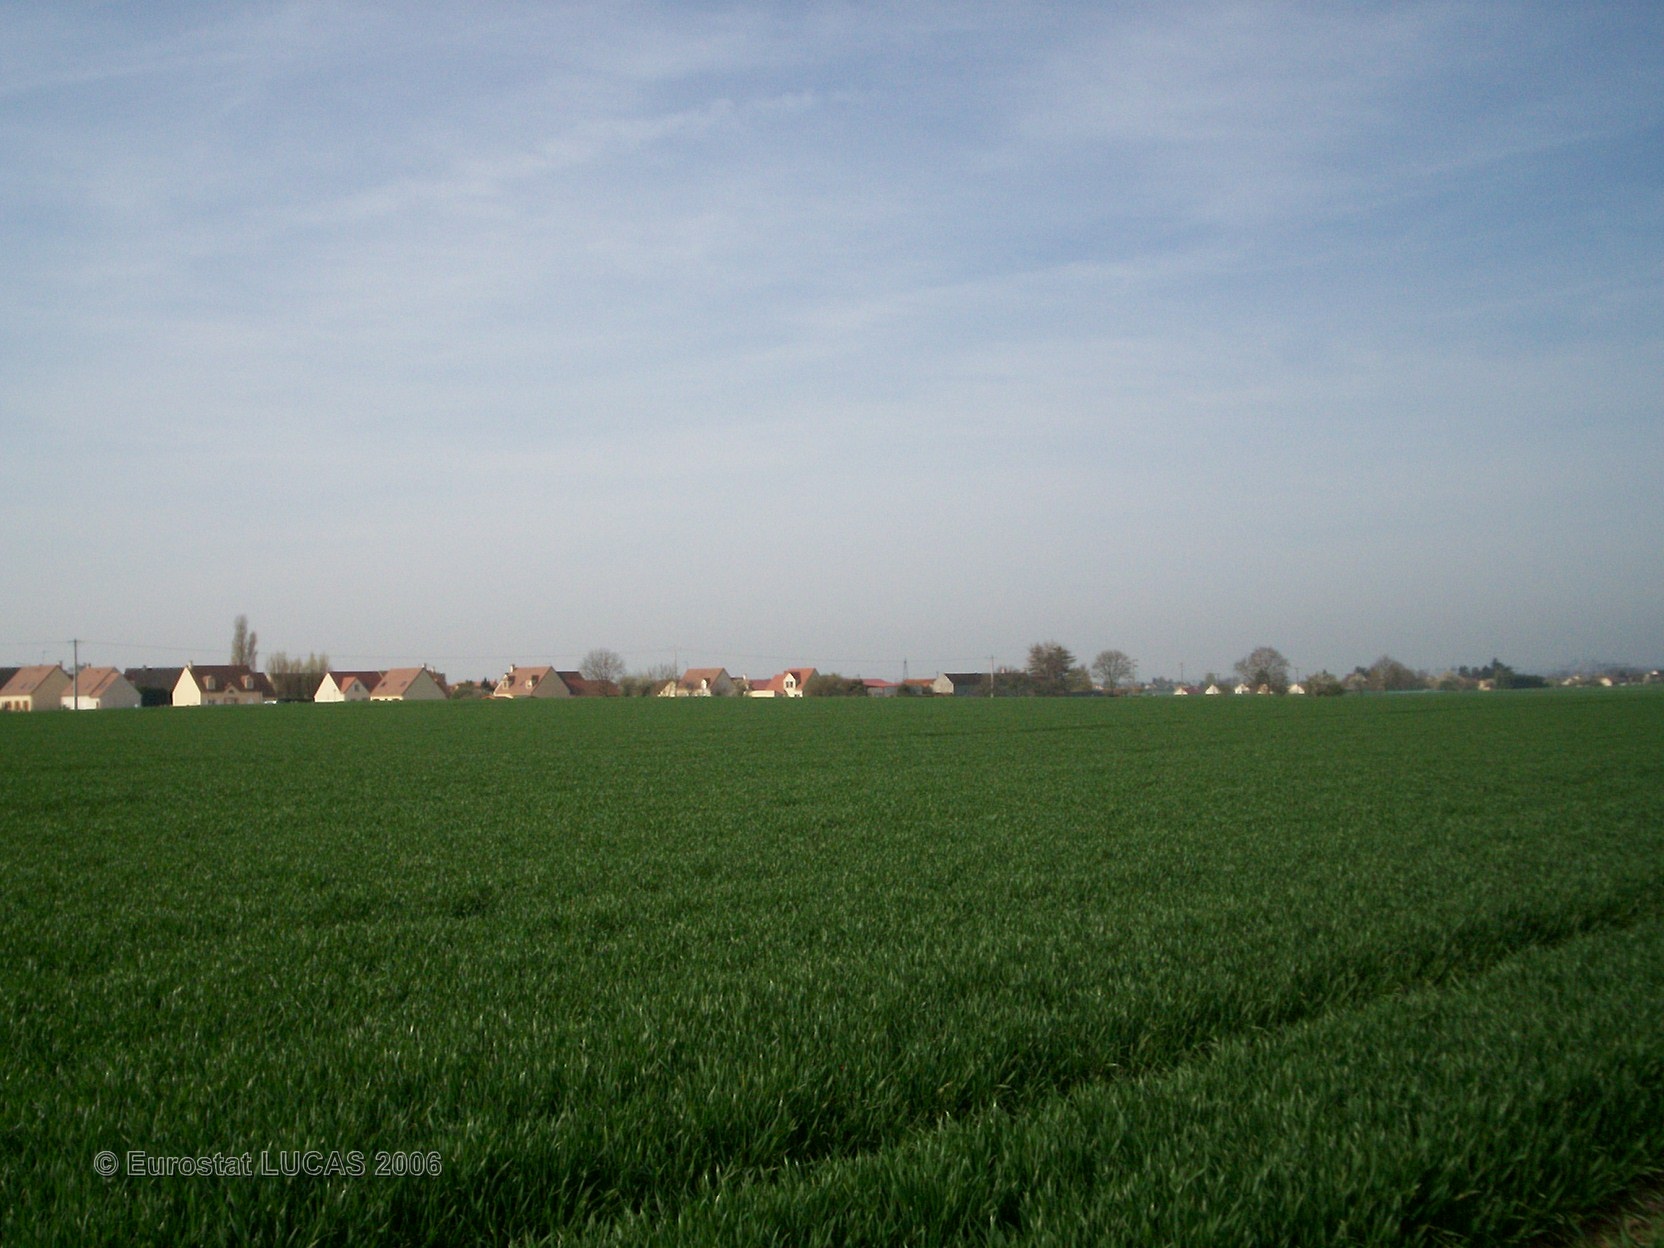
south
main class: Cropland
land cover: Barley
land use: Agriculture (excluding fallow land and kitchen gardens)
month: April
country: FR
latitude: 48.3920
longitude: 2.9015
